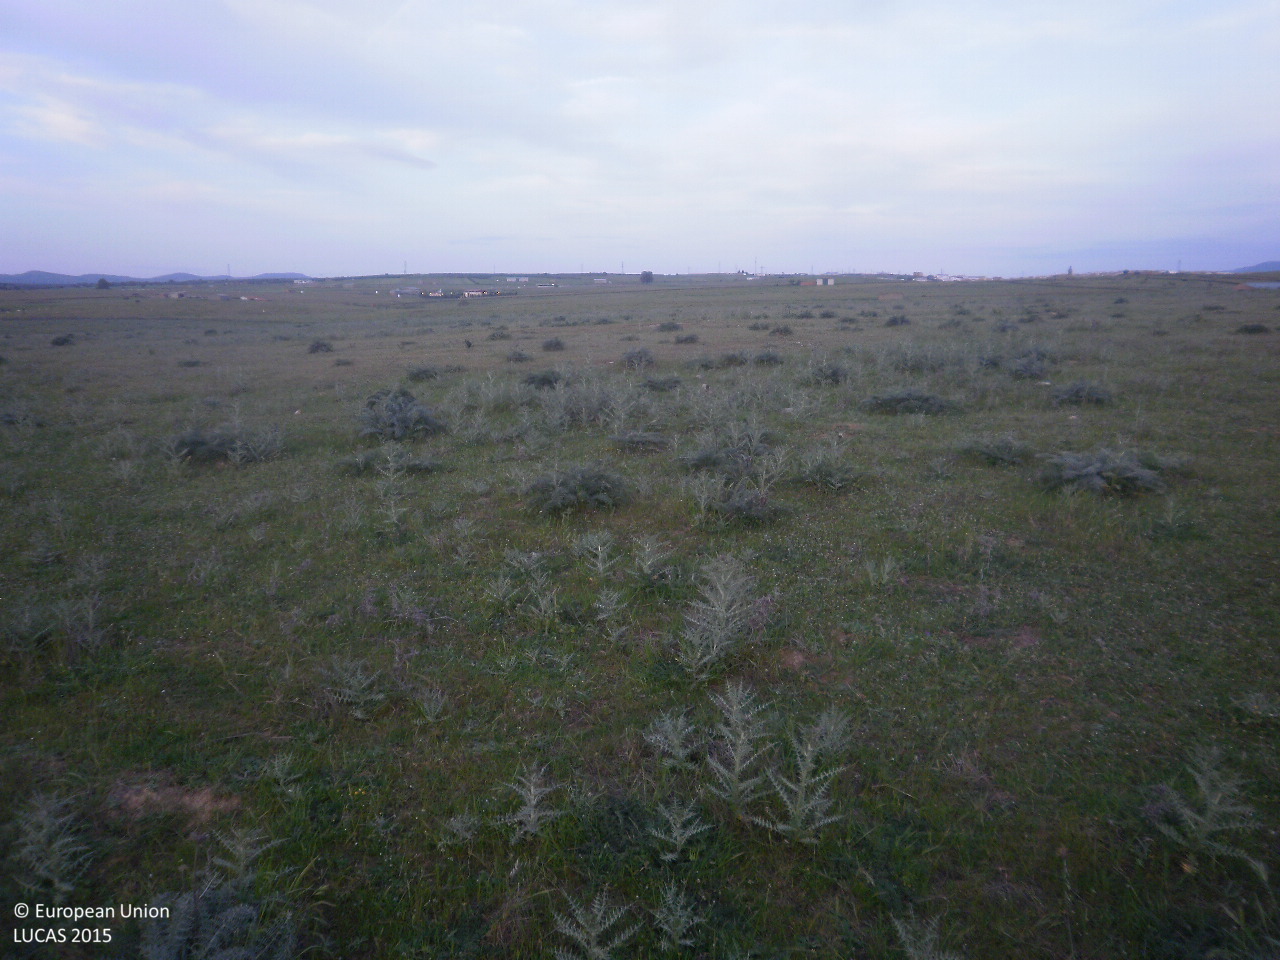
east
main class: Grassland
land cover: Grassland without tree/shrub cover
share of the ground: > 75 %
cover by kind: herbaceous plants 100 %
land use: Agriculture (excluding fallow land and kitchen gardens)
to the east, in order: Grassland without tree/shrub cover; Fences; Dry stone walls; Grassland without tree/shrub cover
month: April
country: ES
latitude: 39.0477
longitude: -5.2577
